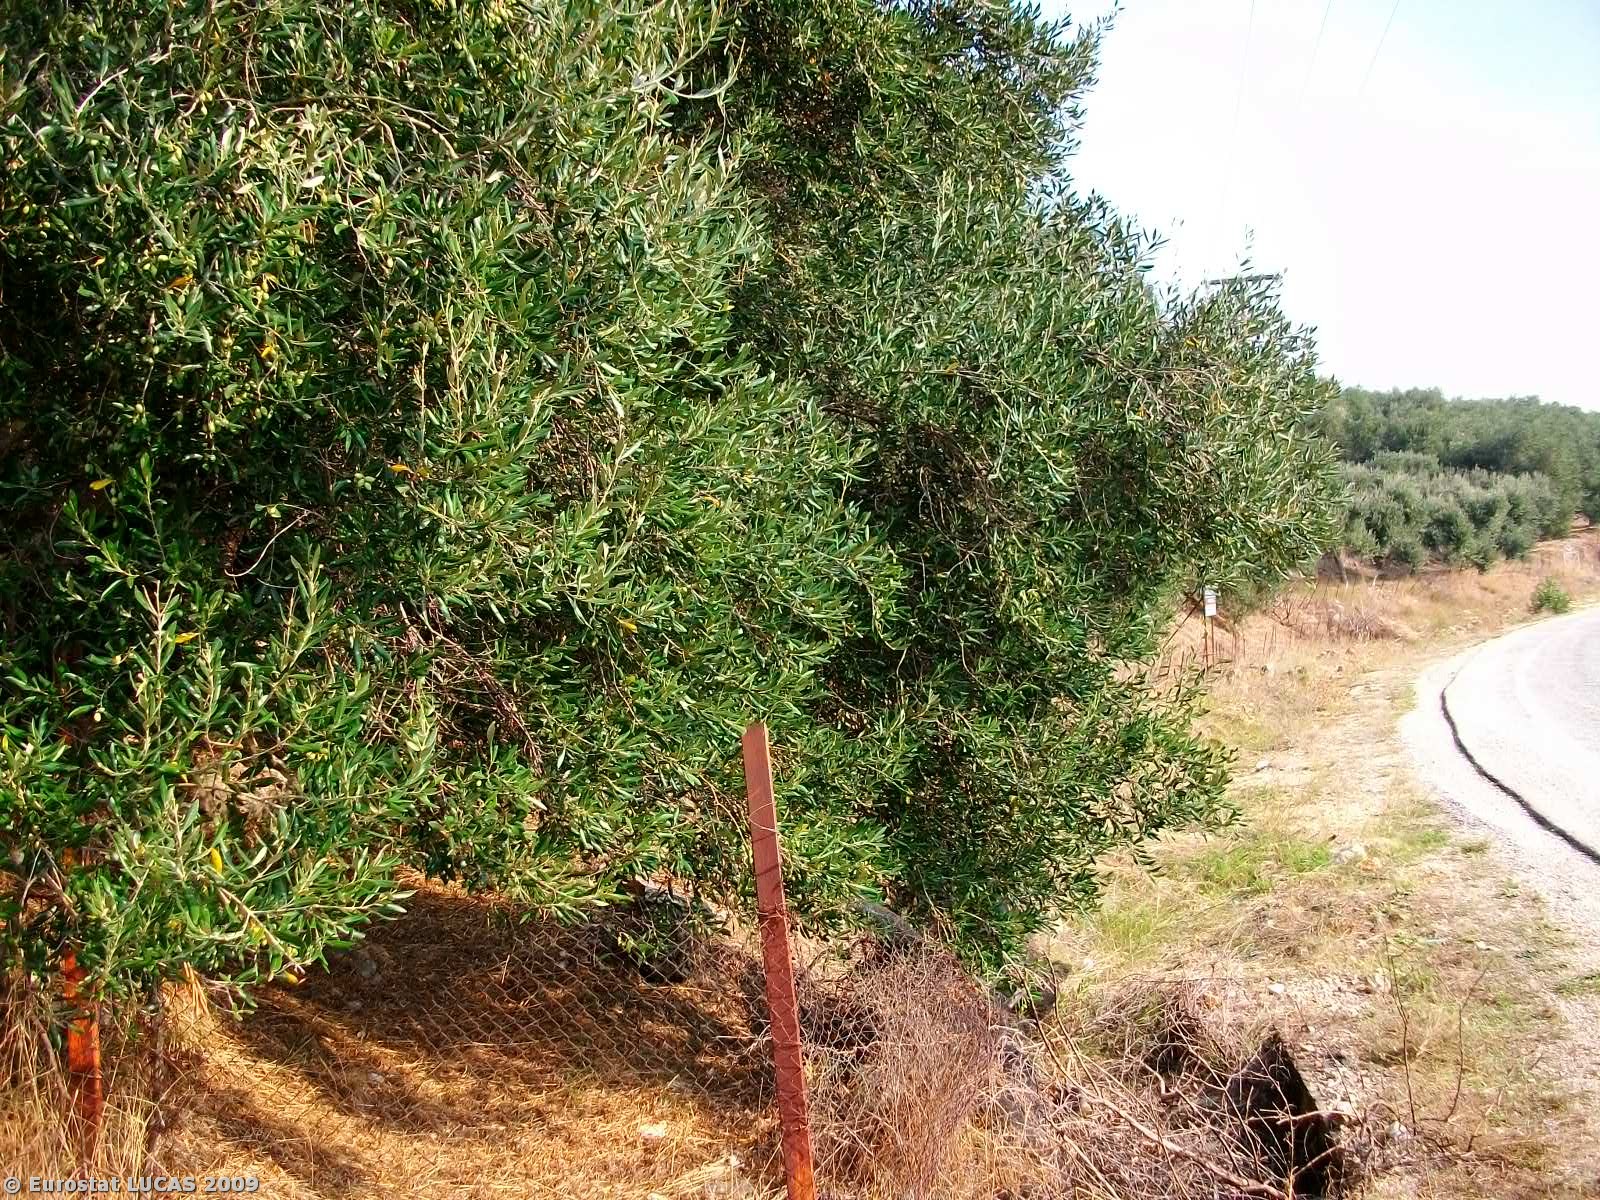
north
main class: Shrubland
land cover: Shrubland without tree cover
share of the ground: > 75 %
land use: Agriculture (excluding fallow land and kitchen gardens)
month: October
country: GR
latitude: 39.2867
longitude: 20.4647
